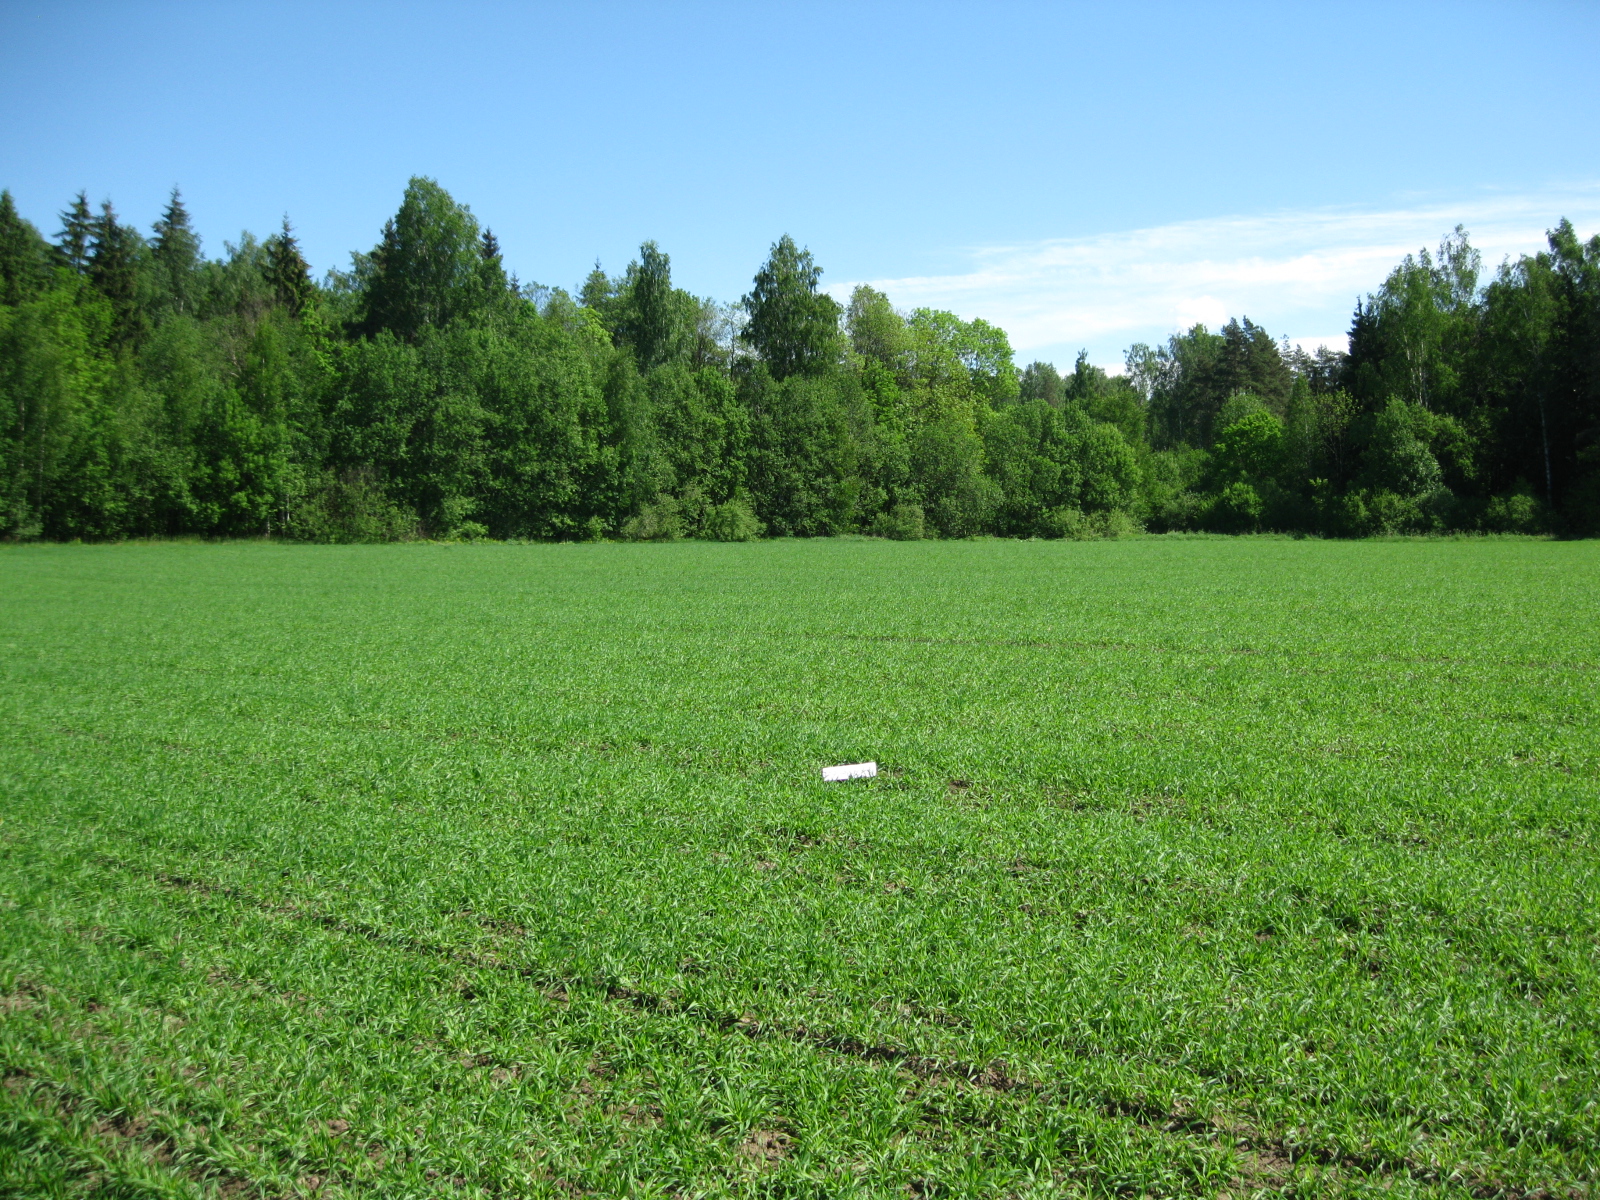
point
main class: Cropland
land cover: Barley
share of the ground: 50 - 75 %
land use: Agriculture (excluding fallow land and kitchen gardens)
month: May
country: LT
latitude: 55.7797
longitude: 24.3333
